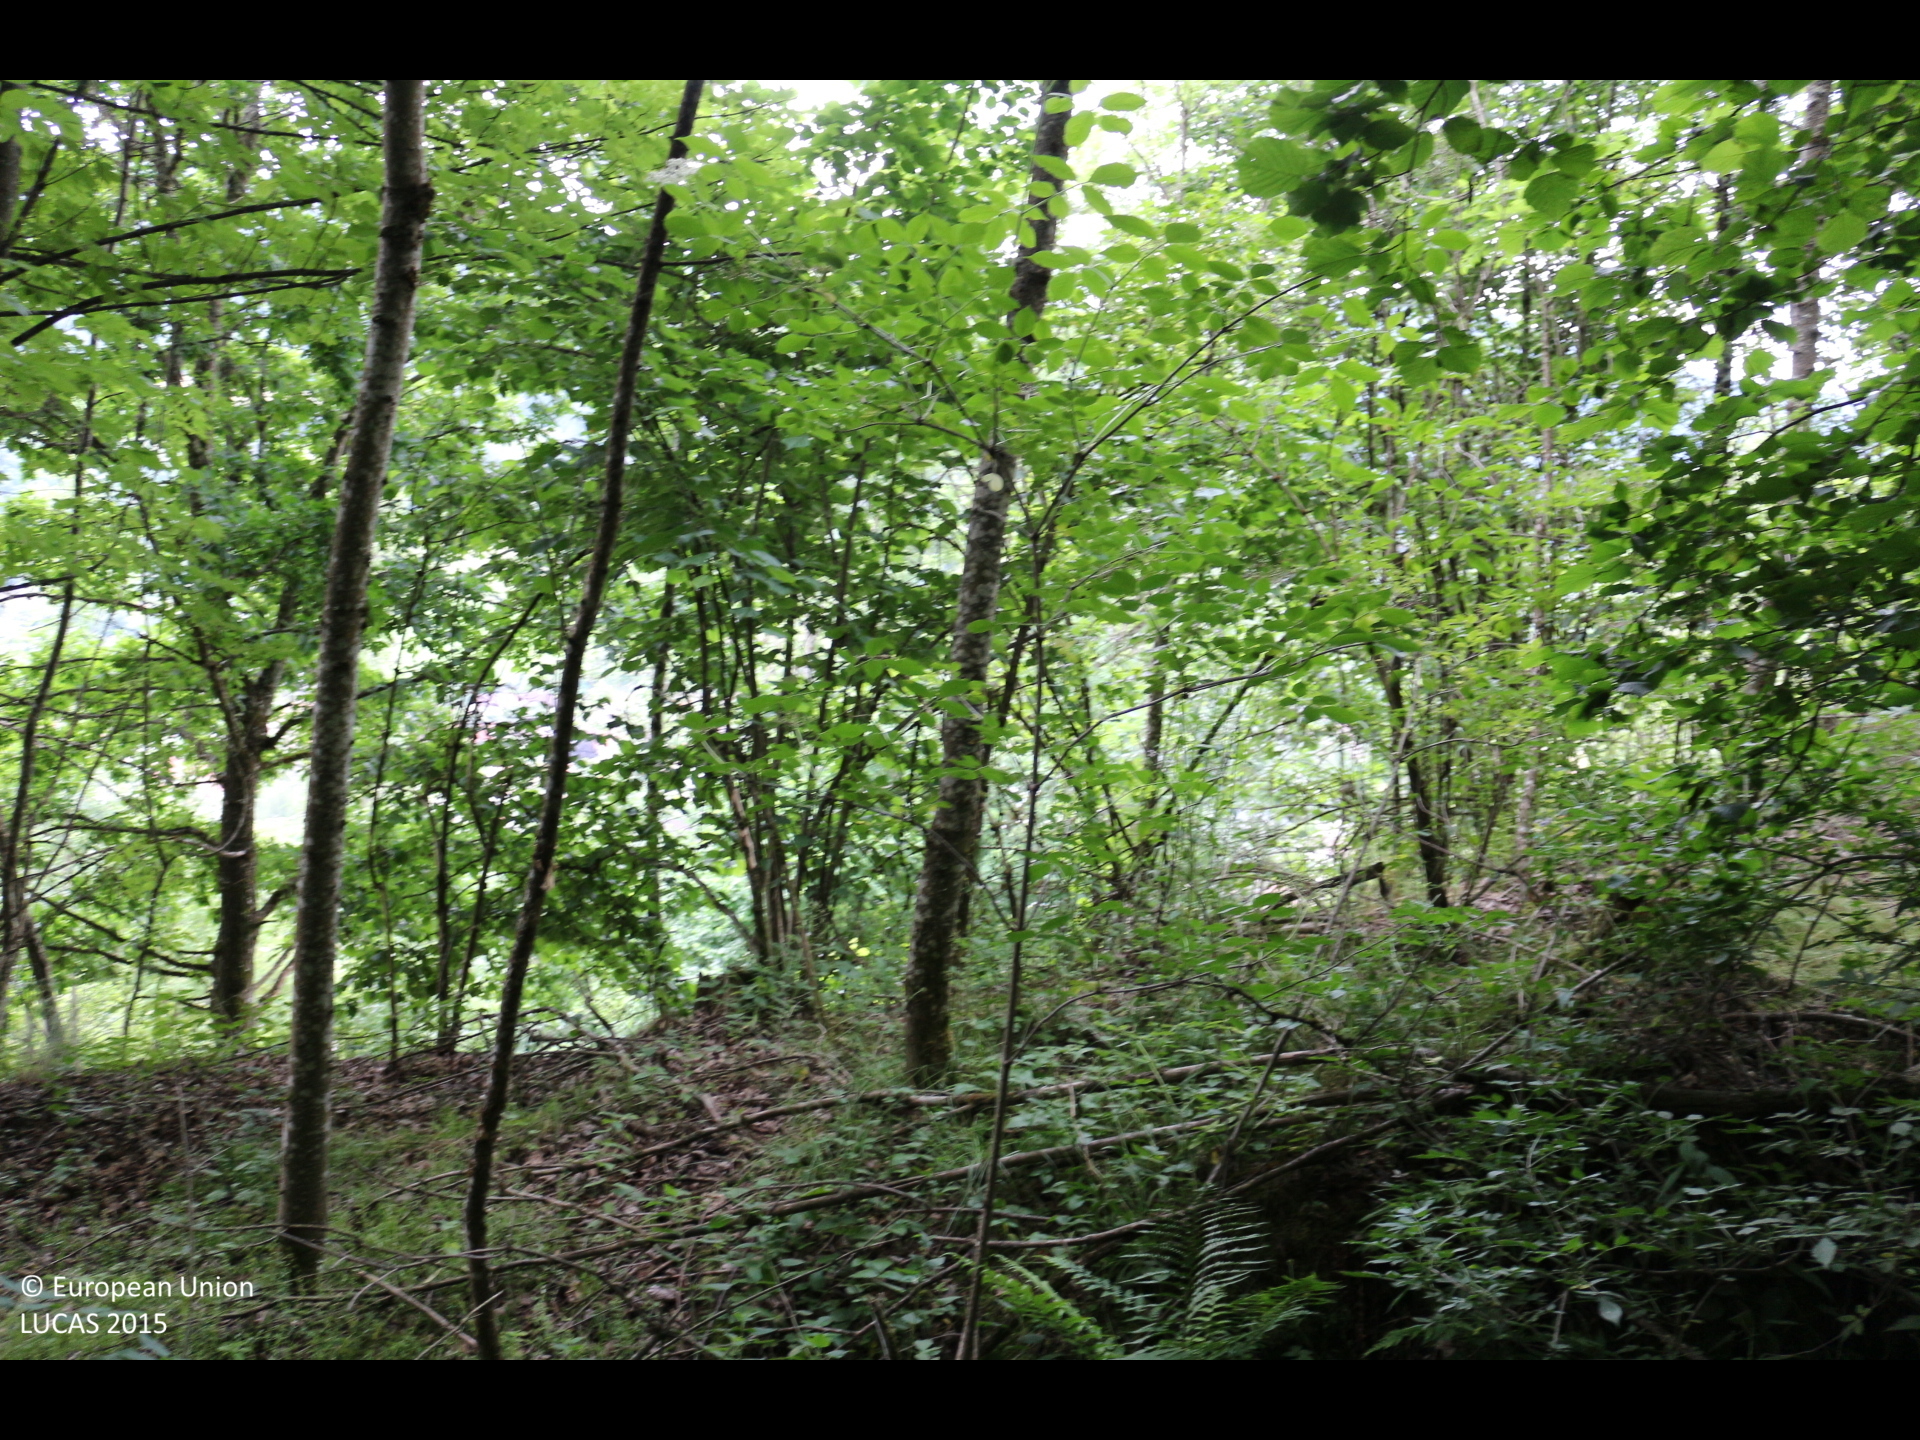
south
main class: Woodland
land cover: Broadleaved woodland
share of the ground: > 75 %
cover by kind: broadleaved forest trees 90 %, herbaceous plants 10 %
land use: Forestry
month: June
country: AT
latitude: 46.8784
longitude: 14.2886
